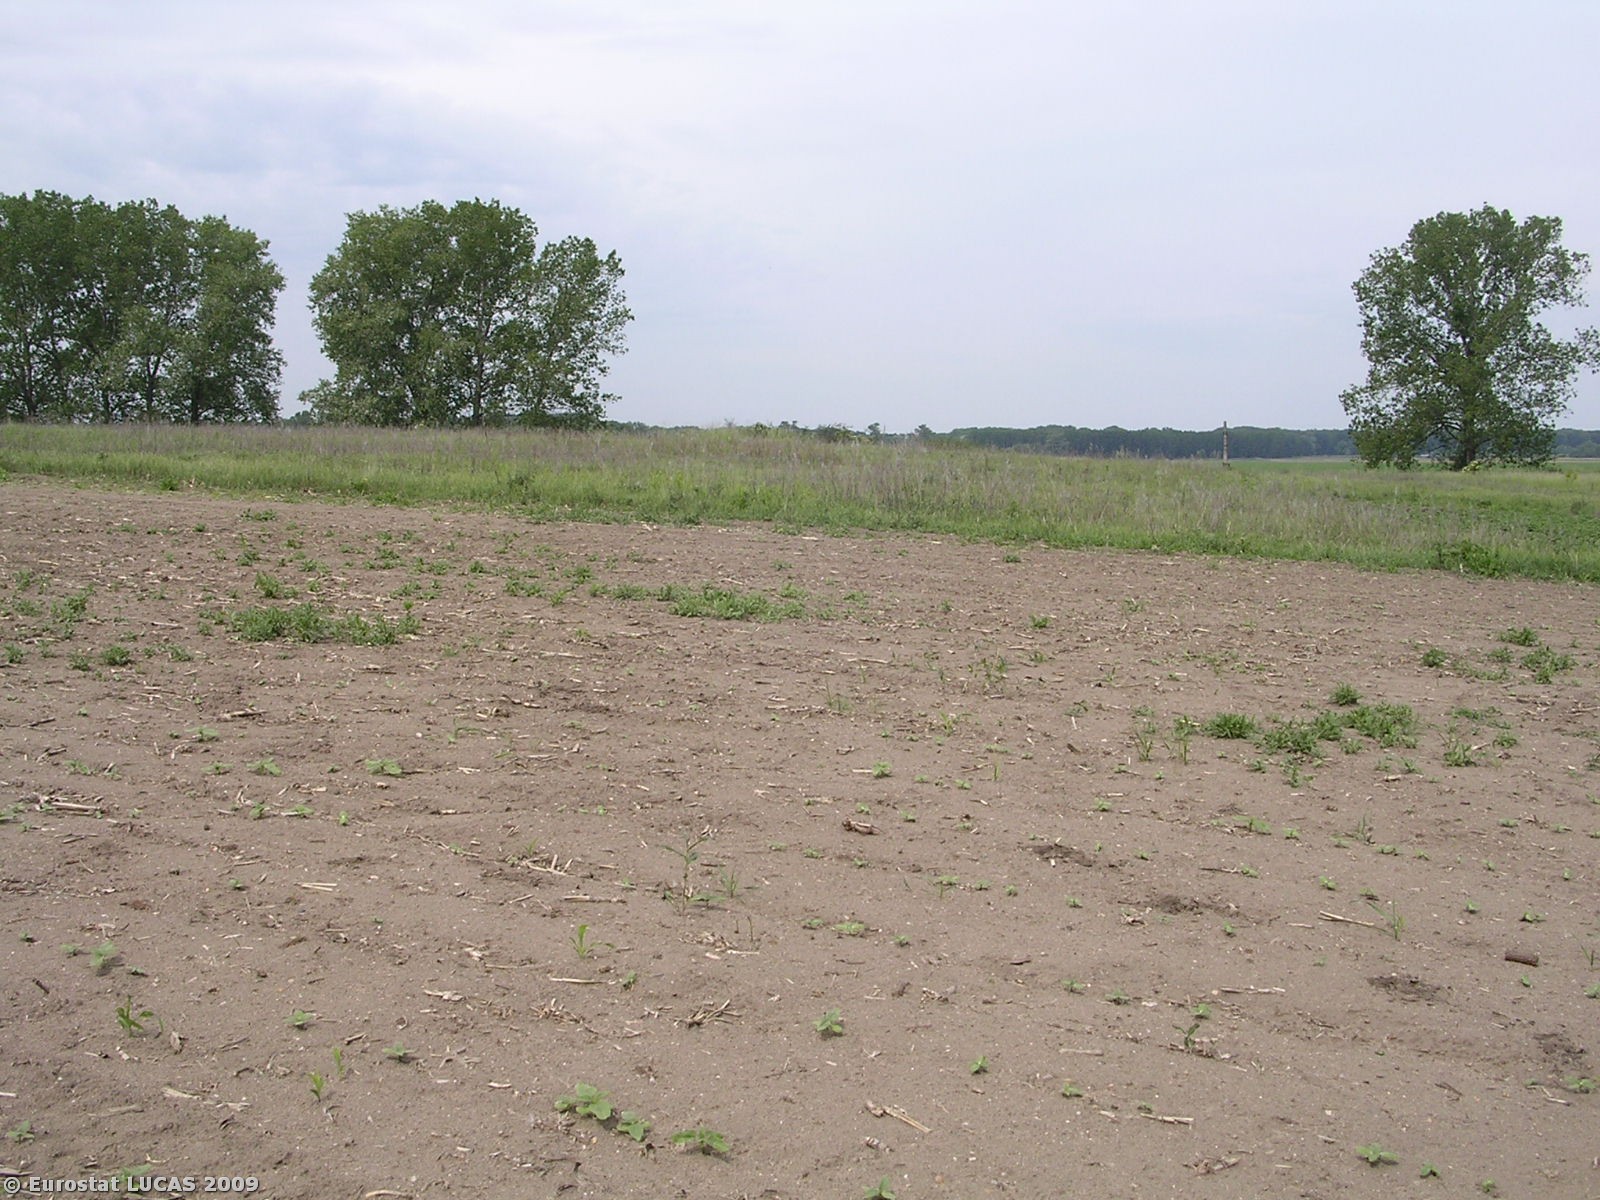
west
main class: Cropland
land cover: Sunflower
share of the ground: < 10 %
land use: Agriculture (excluding fallow land and kitchen gardens)
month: May
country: CZ
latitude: 50.3112
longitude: 14.5093
